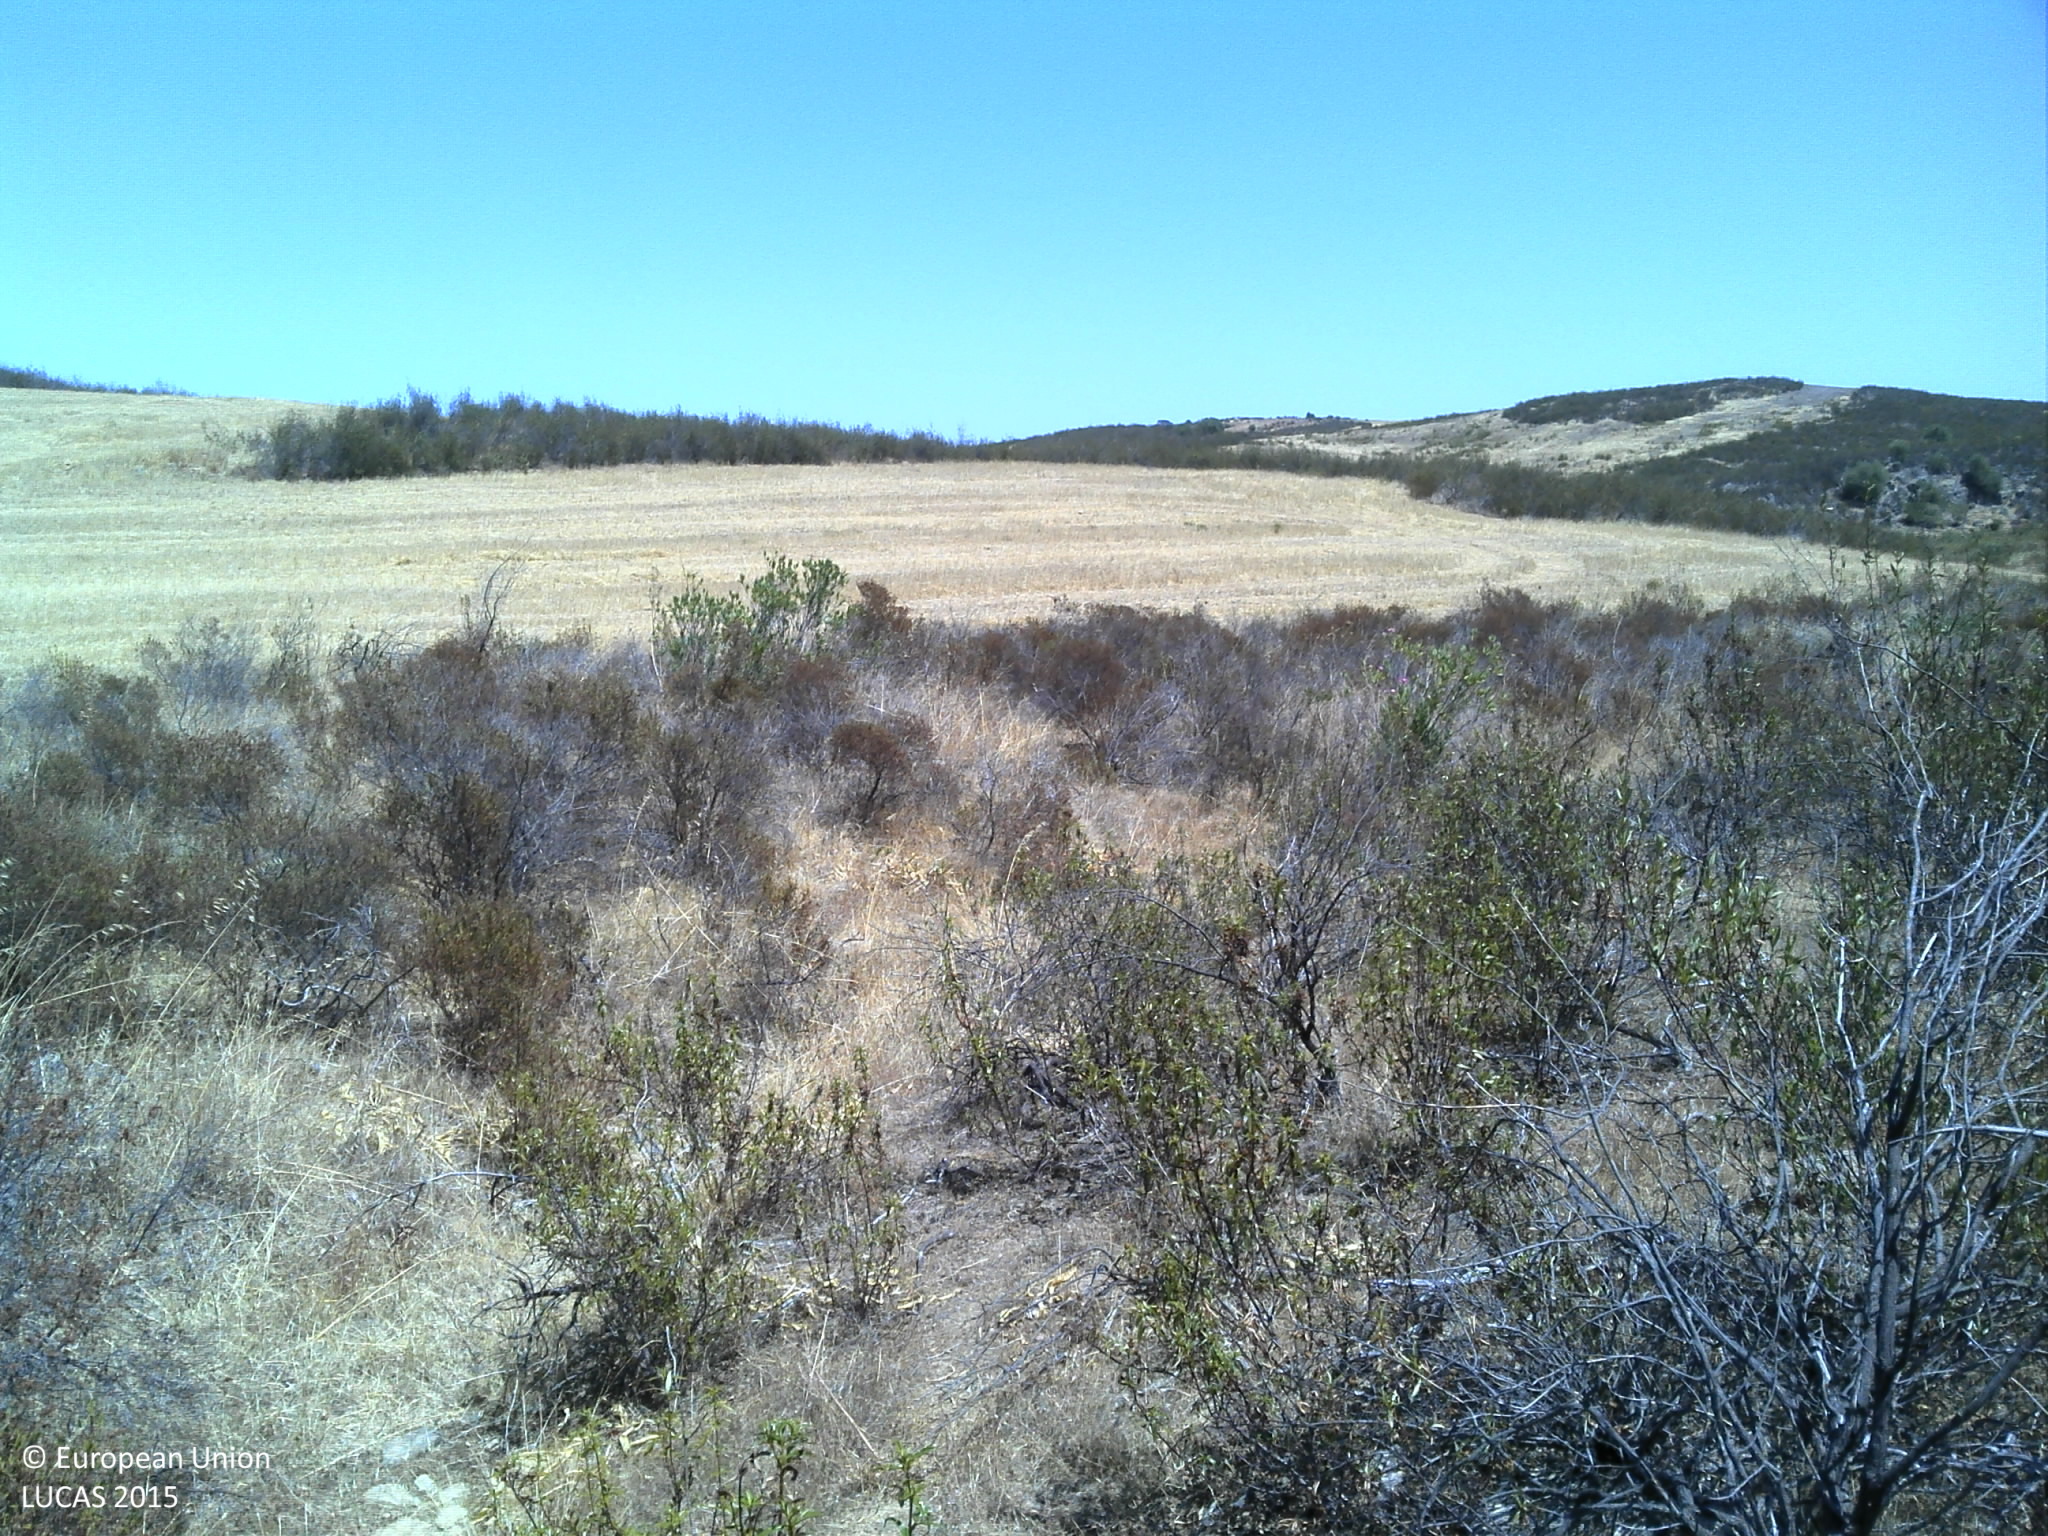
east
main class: Shrubland
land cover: Shrubland with sparse tree cover
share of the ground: 50 - 75 %
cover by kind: shrubs 65 %, herbaceous plants 20 %, unconsolidated bare surface 10 %, broadleaved forest trees 5 %
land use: Abandoned areas
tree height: < 5 m
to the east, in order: Shrubland with sparse tree cover; Rivers and streams; Shrubland without tree cover; Grass margins; Triticale; Shrubland without tree cover; Grassland without tree/shrub cover; Shrubland without tree cover; Triticale; Shrubland without tree cover; Inland fresh running water; Grassland without tree/shrub cover; Olive groves
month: July
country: PT
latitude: 37.5843
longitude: -7.9241
